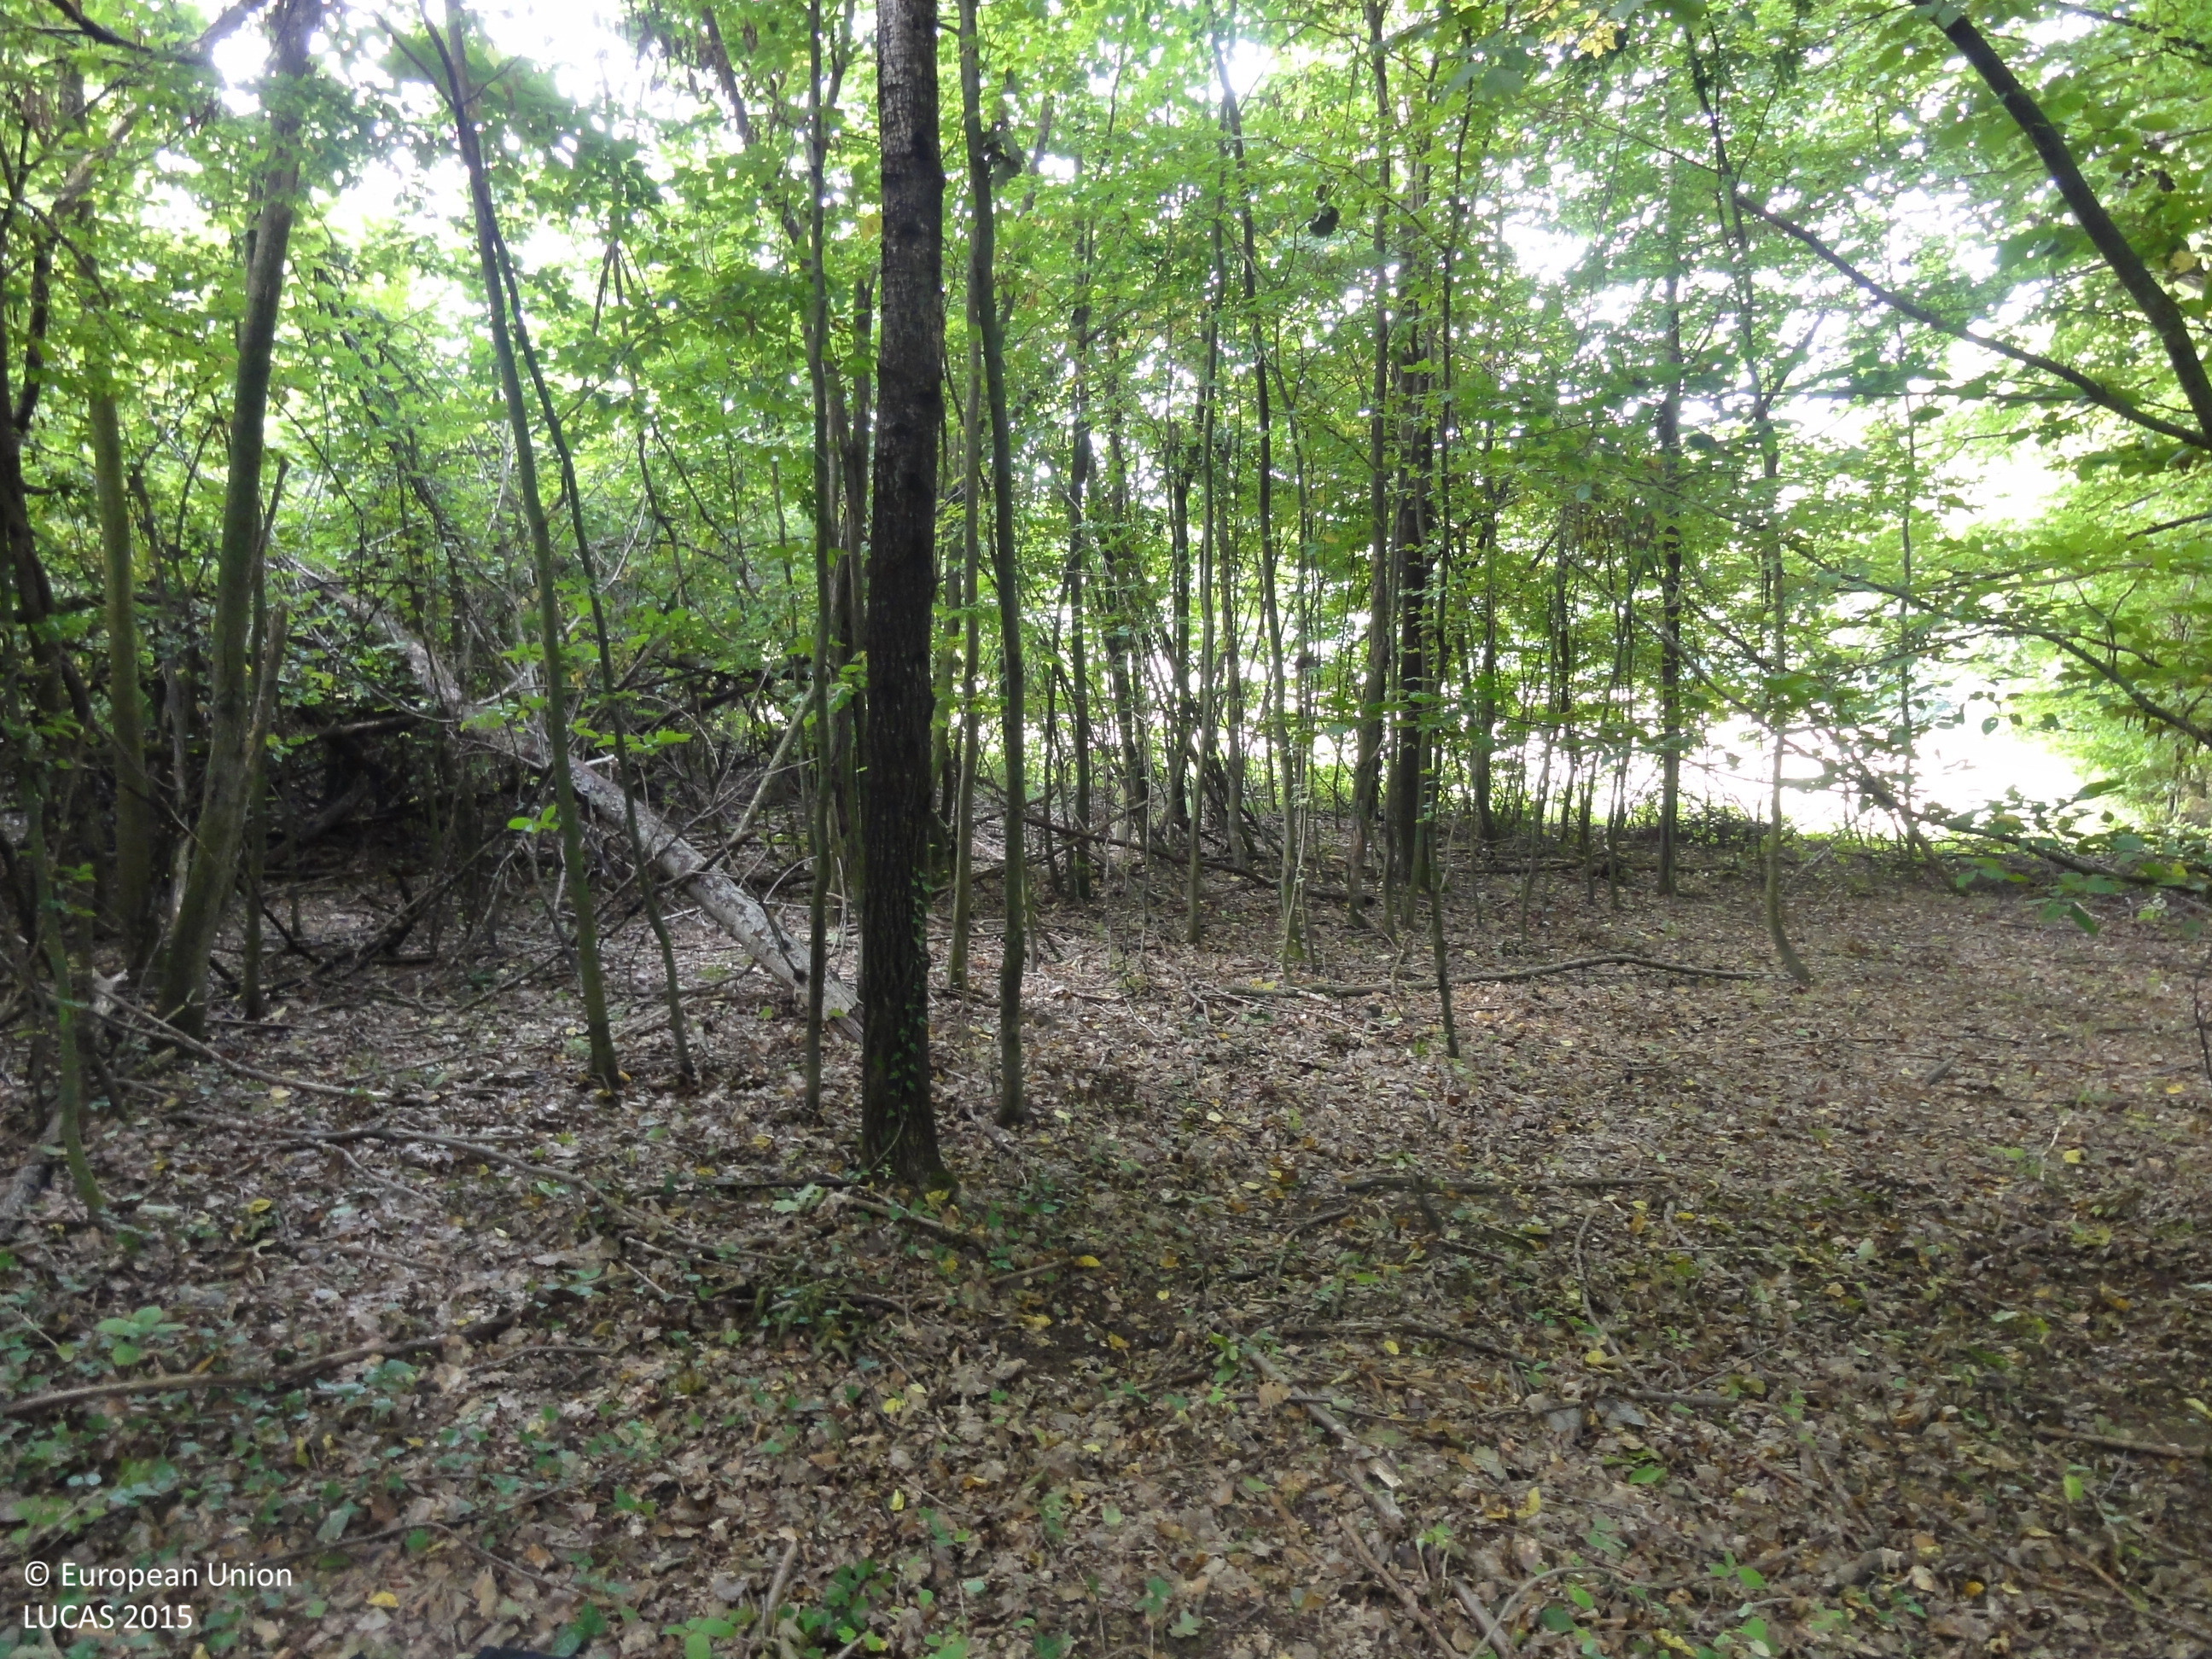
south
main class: Woodland
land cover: Broadleaved woodland
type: beech forest
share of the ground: > 75 %
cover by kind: broadleaved forest trees 90 %, shrubs 10 %
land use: Forestry
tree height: > 5 m
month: August
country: SI
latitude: 45.9665
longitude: 15.6628
